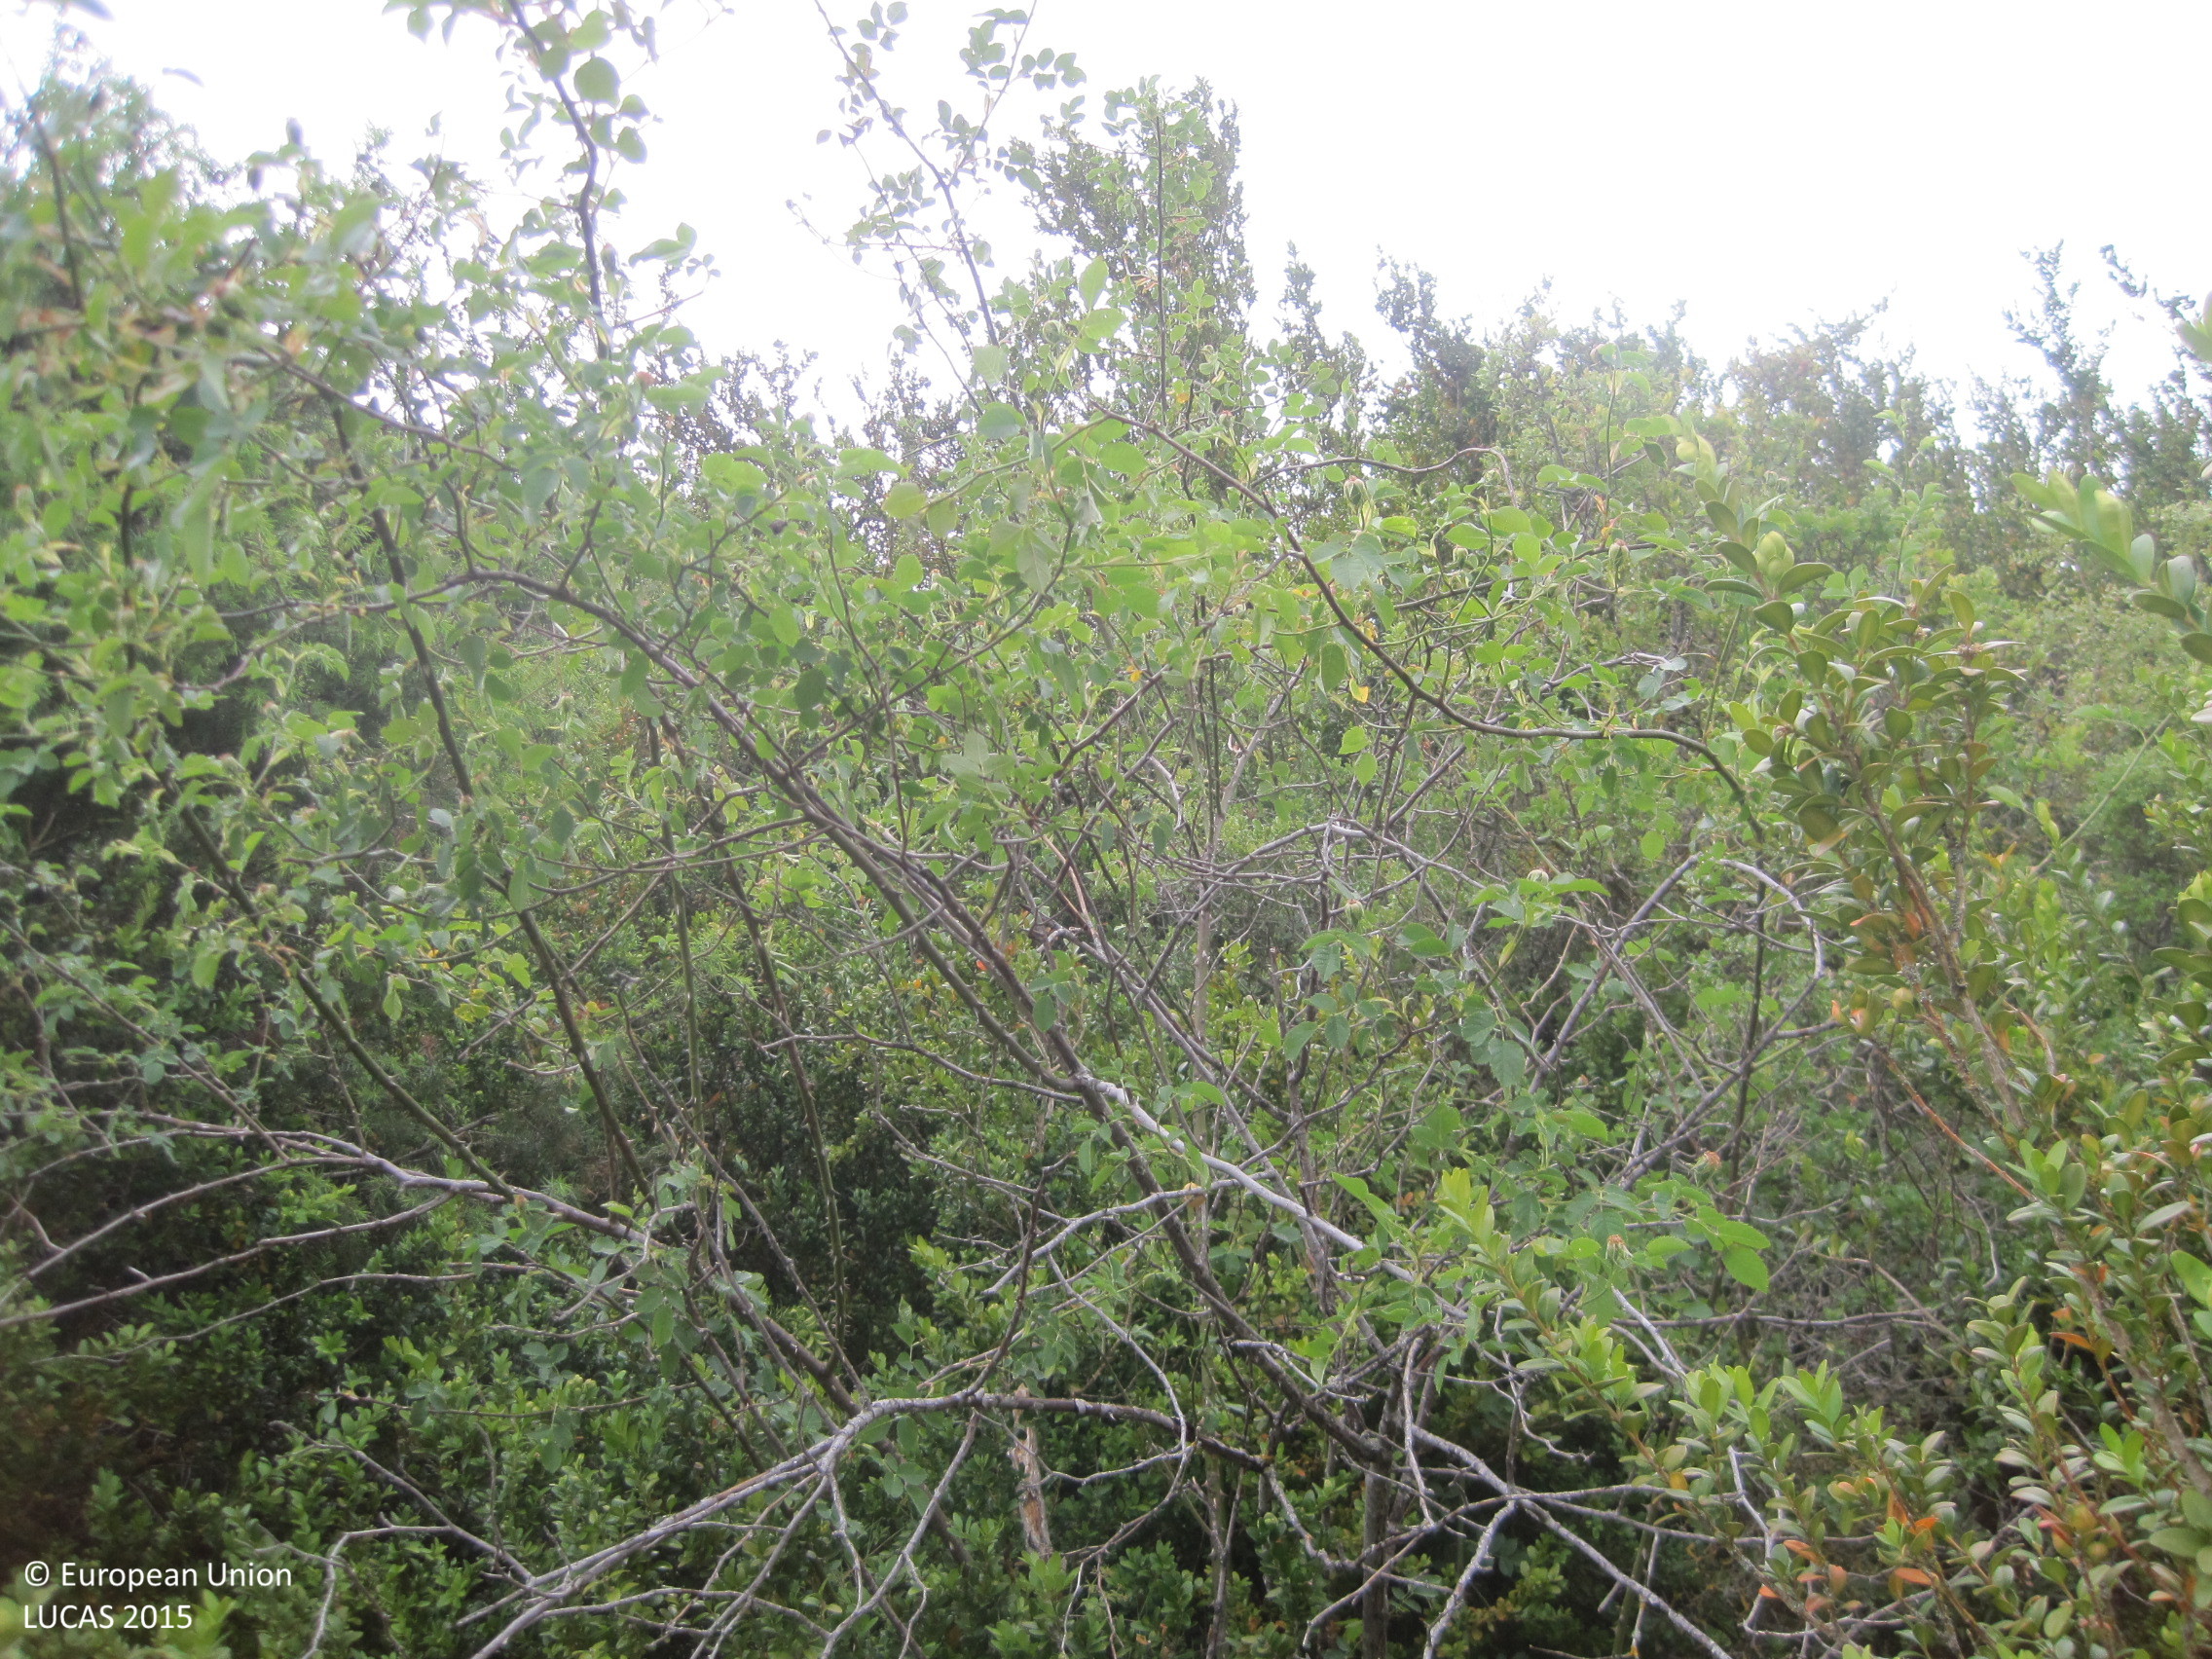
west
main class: Shrubland
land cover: Shrubland without tree cover
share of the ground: > 75 %
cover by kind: shrubs 50 %, herbaceous plants 30 %, unconsolidated bare surface 20 %
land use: Agriculture (excluding fallow land and kitchen gardens)
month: June
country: ES
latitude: 42.7015
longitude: -1.2286
